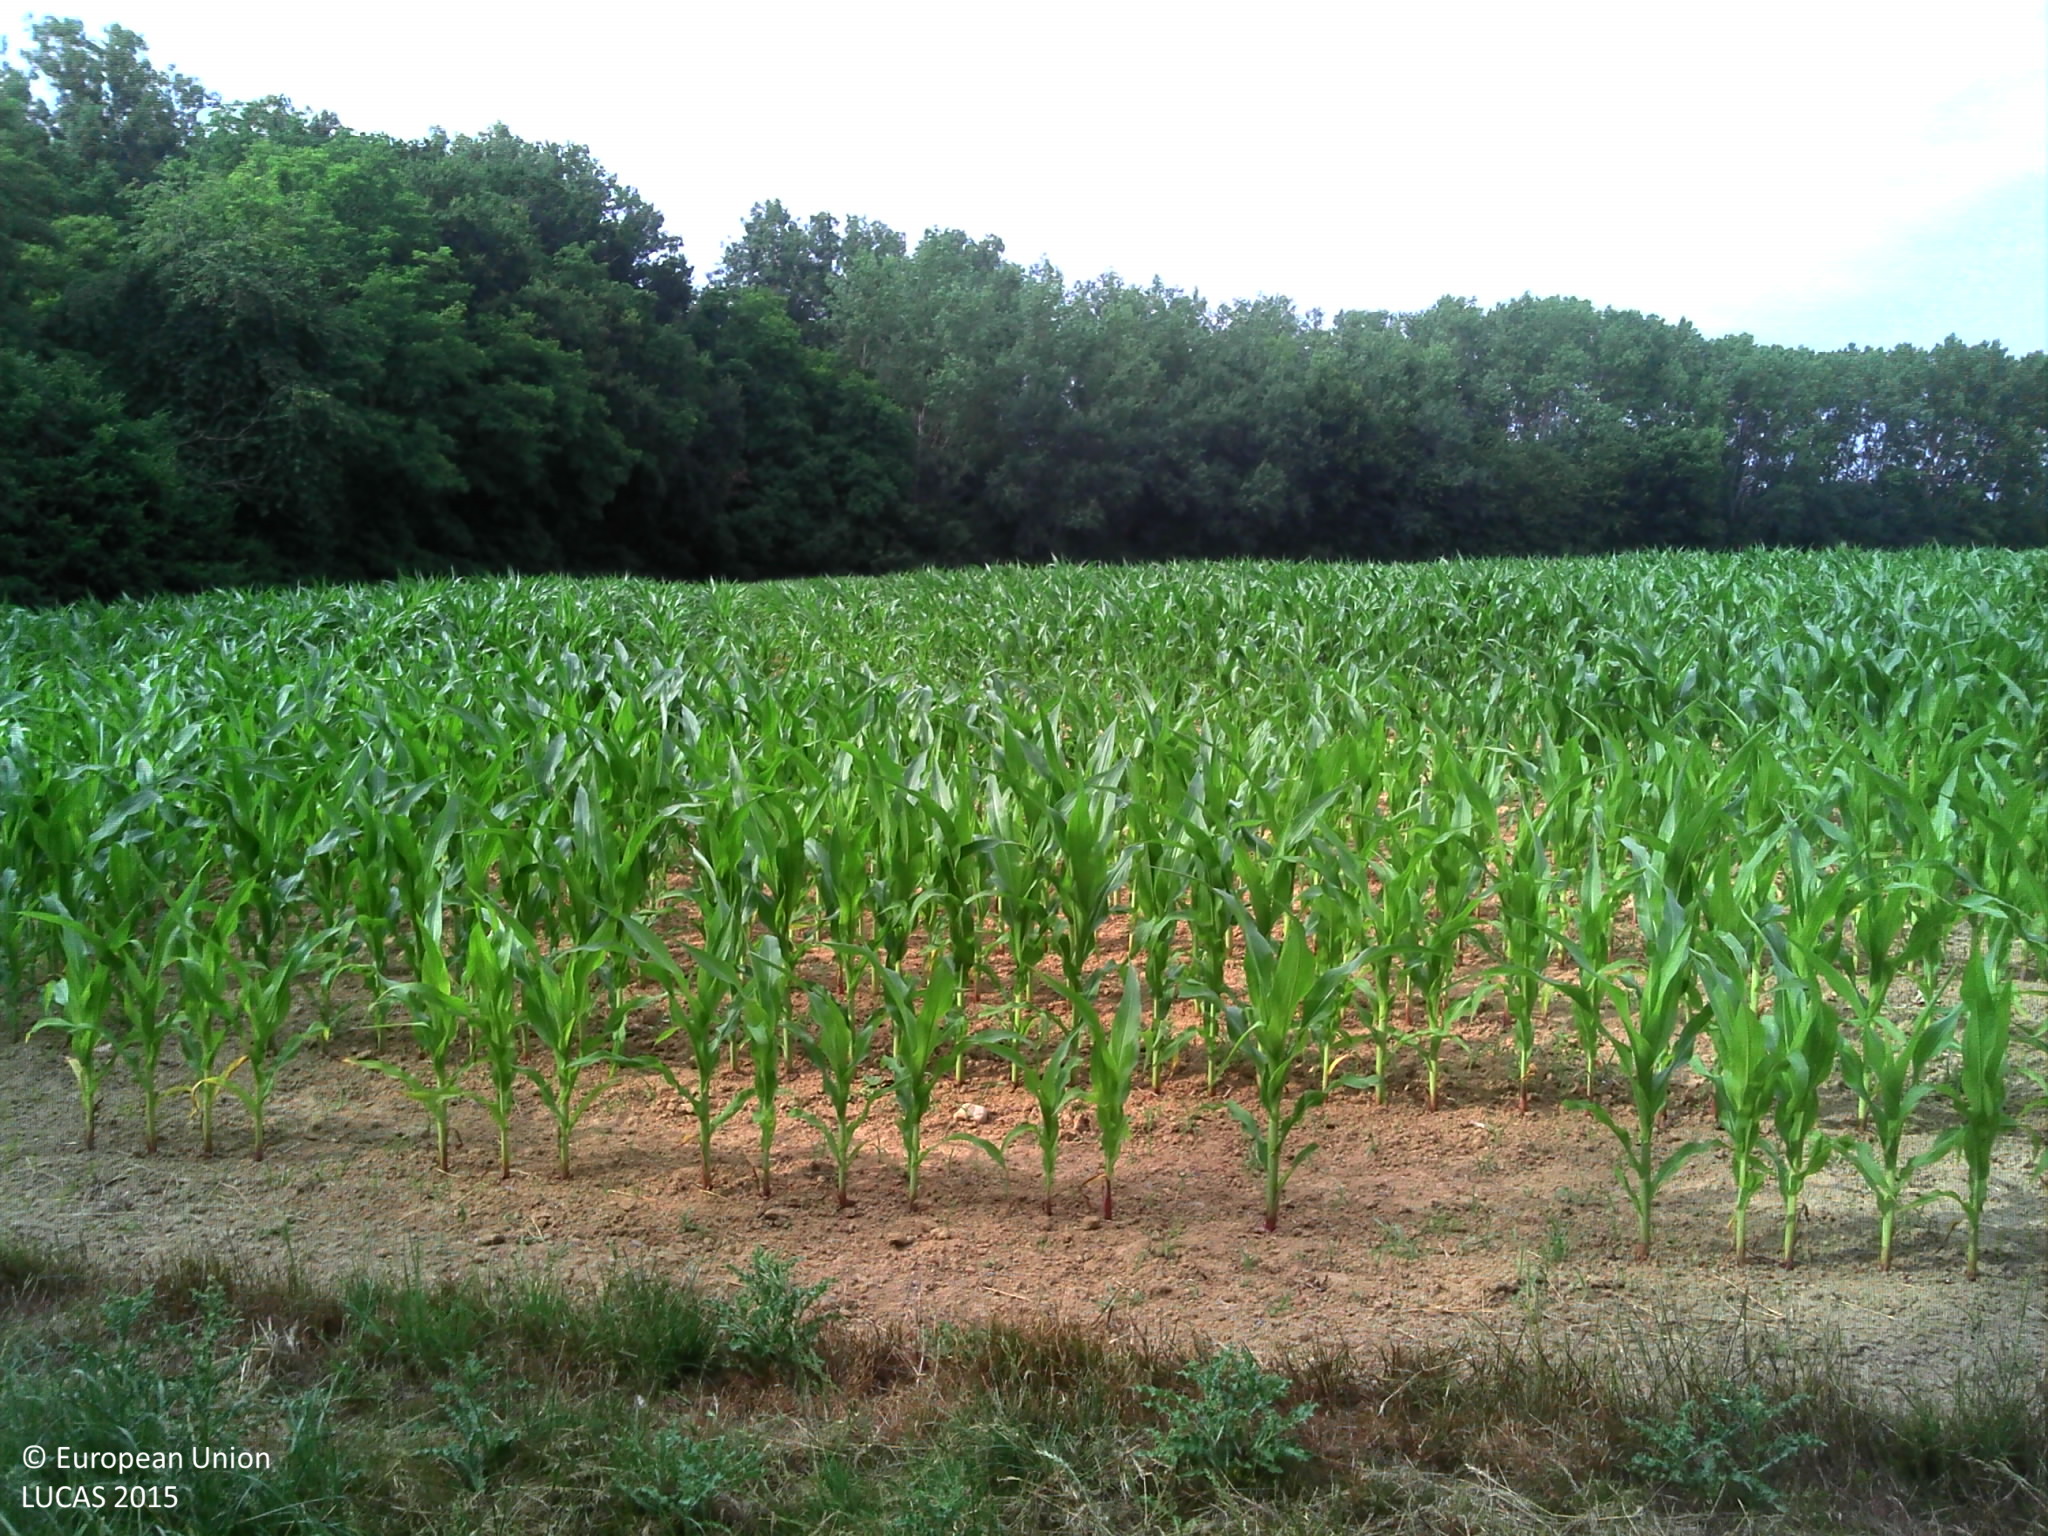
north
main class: Grassland
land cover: Grassland without tree/shrub cover
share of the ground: > 75 %
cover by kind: herbaceous plants 100 %
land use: Agriculture (excluding fallow land and kitchen gardens)
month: June
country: FR
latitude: 46.0645
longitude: 4.8448
